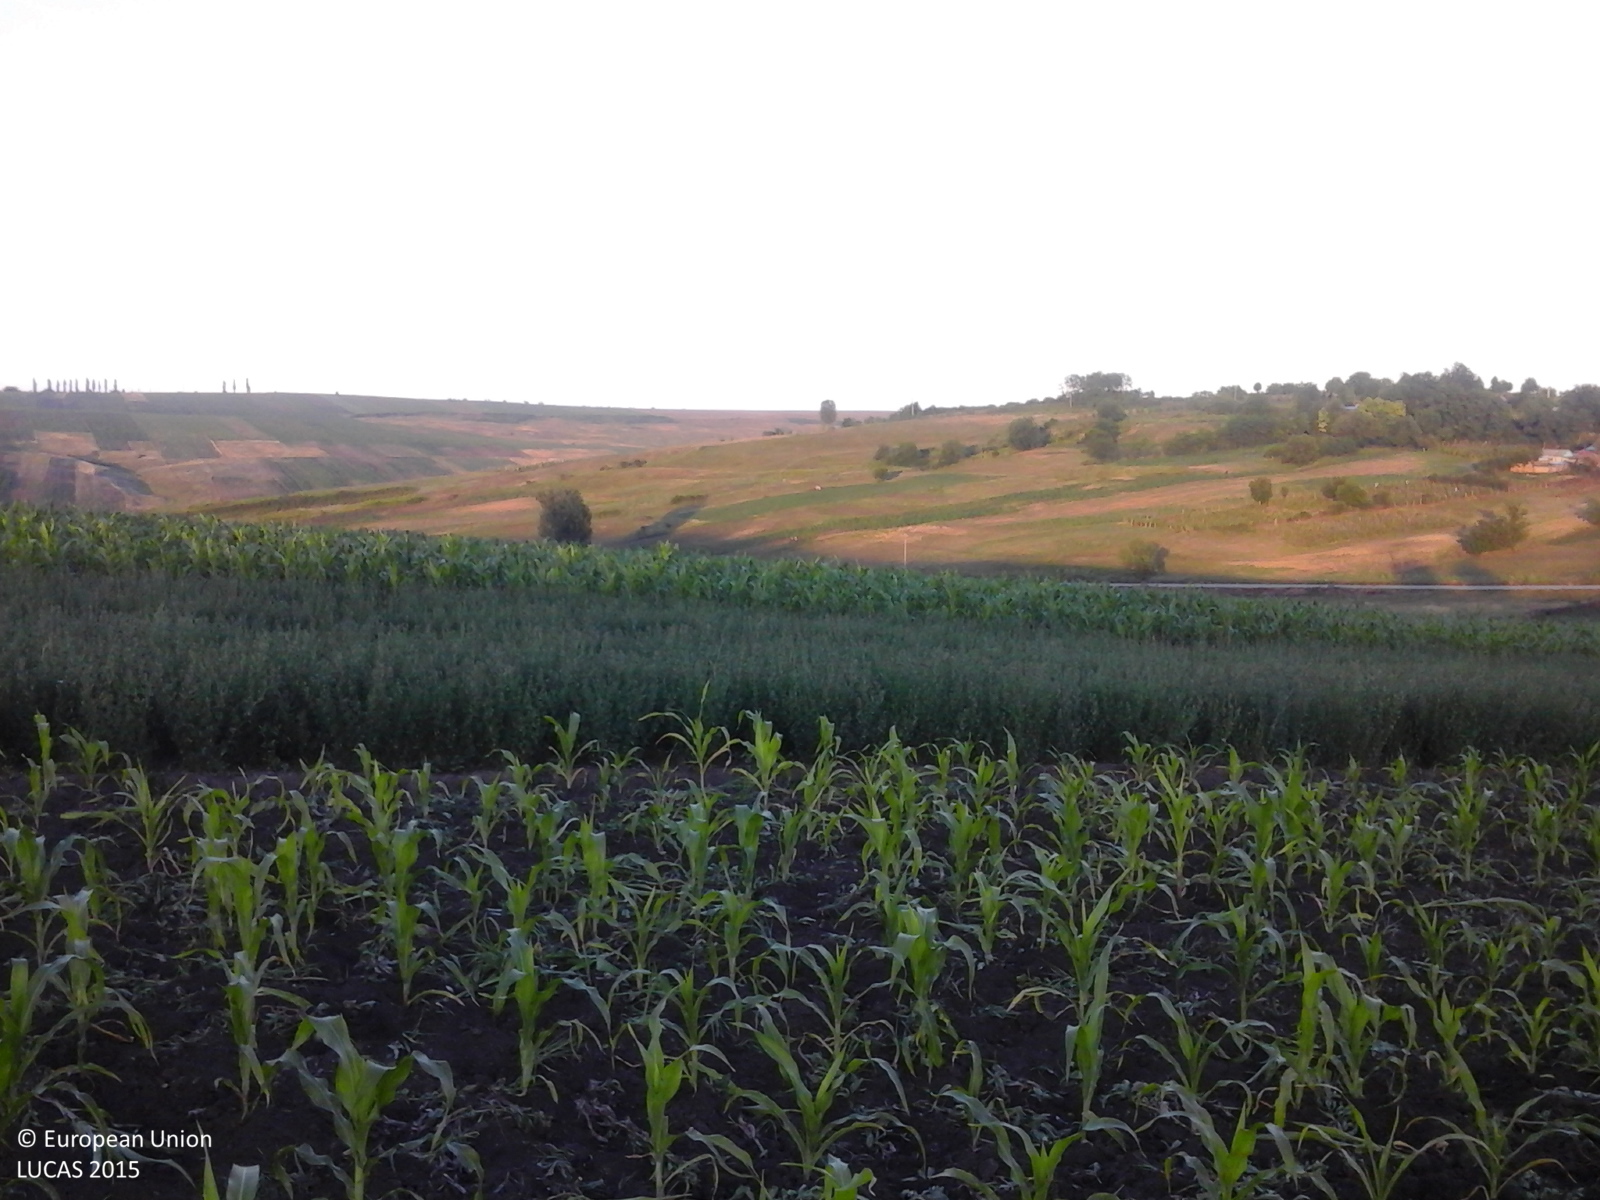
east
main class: Cropland
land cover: Maize
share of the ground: 50 - 75 %
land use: Agriculture (excluding fallow land and kitchen gardens)
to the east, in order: Maize; Lucerne; Maize; Lucerne; Maize; Lucerne; Spontaneously vegetated surfaces; Maize; Lucerne; Grassland without tree/shrub cover; Tracks; Grass margins; Maize; Lucerne; Maize
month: June
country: RO
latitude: 47.1628
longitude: 27.1346
